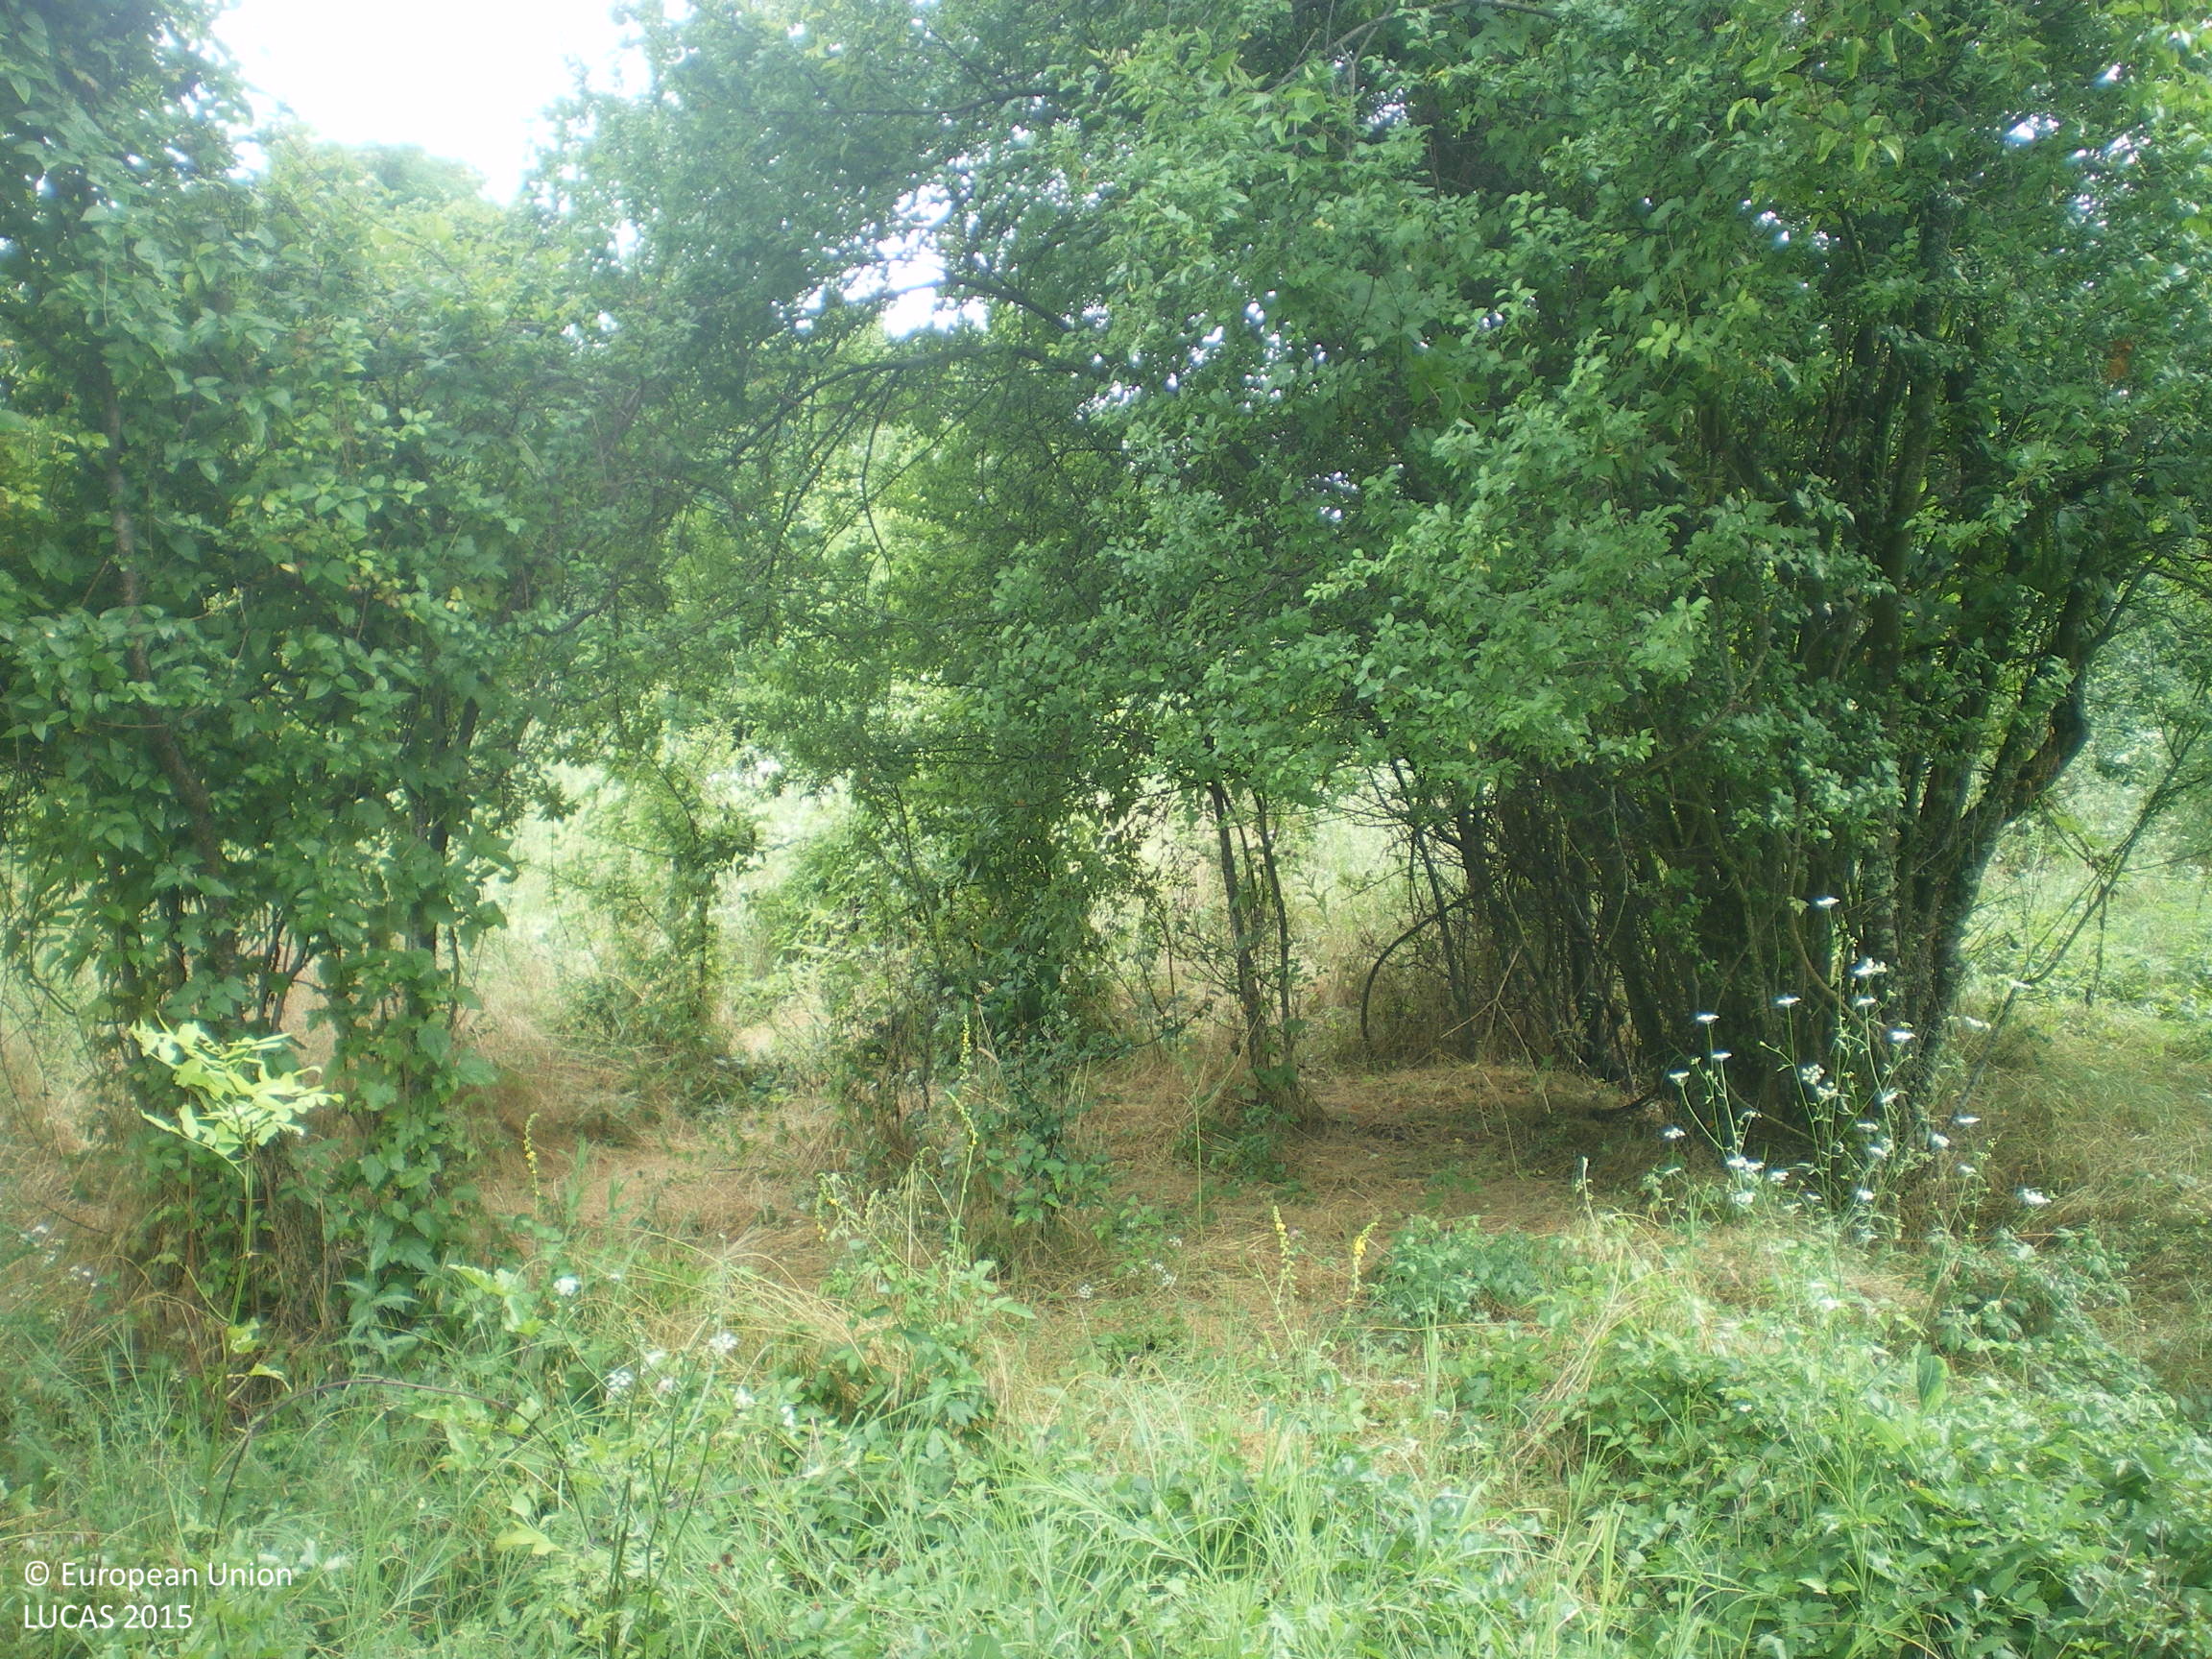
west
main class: Woodland
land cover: Broadleaved woodland
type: mesophytic deciduous forest
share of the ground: 50 - 75 %
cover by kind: broadleaved forest trees 50 %, herbaceous plants 30 %, shrubs 20 %
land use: Semi-natural and natural areas not in use
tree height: > 5 m
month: July
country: BG
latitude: 42.3888
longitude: 25.2599
